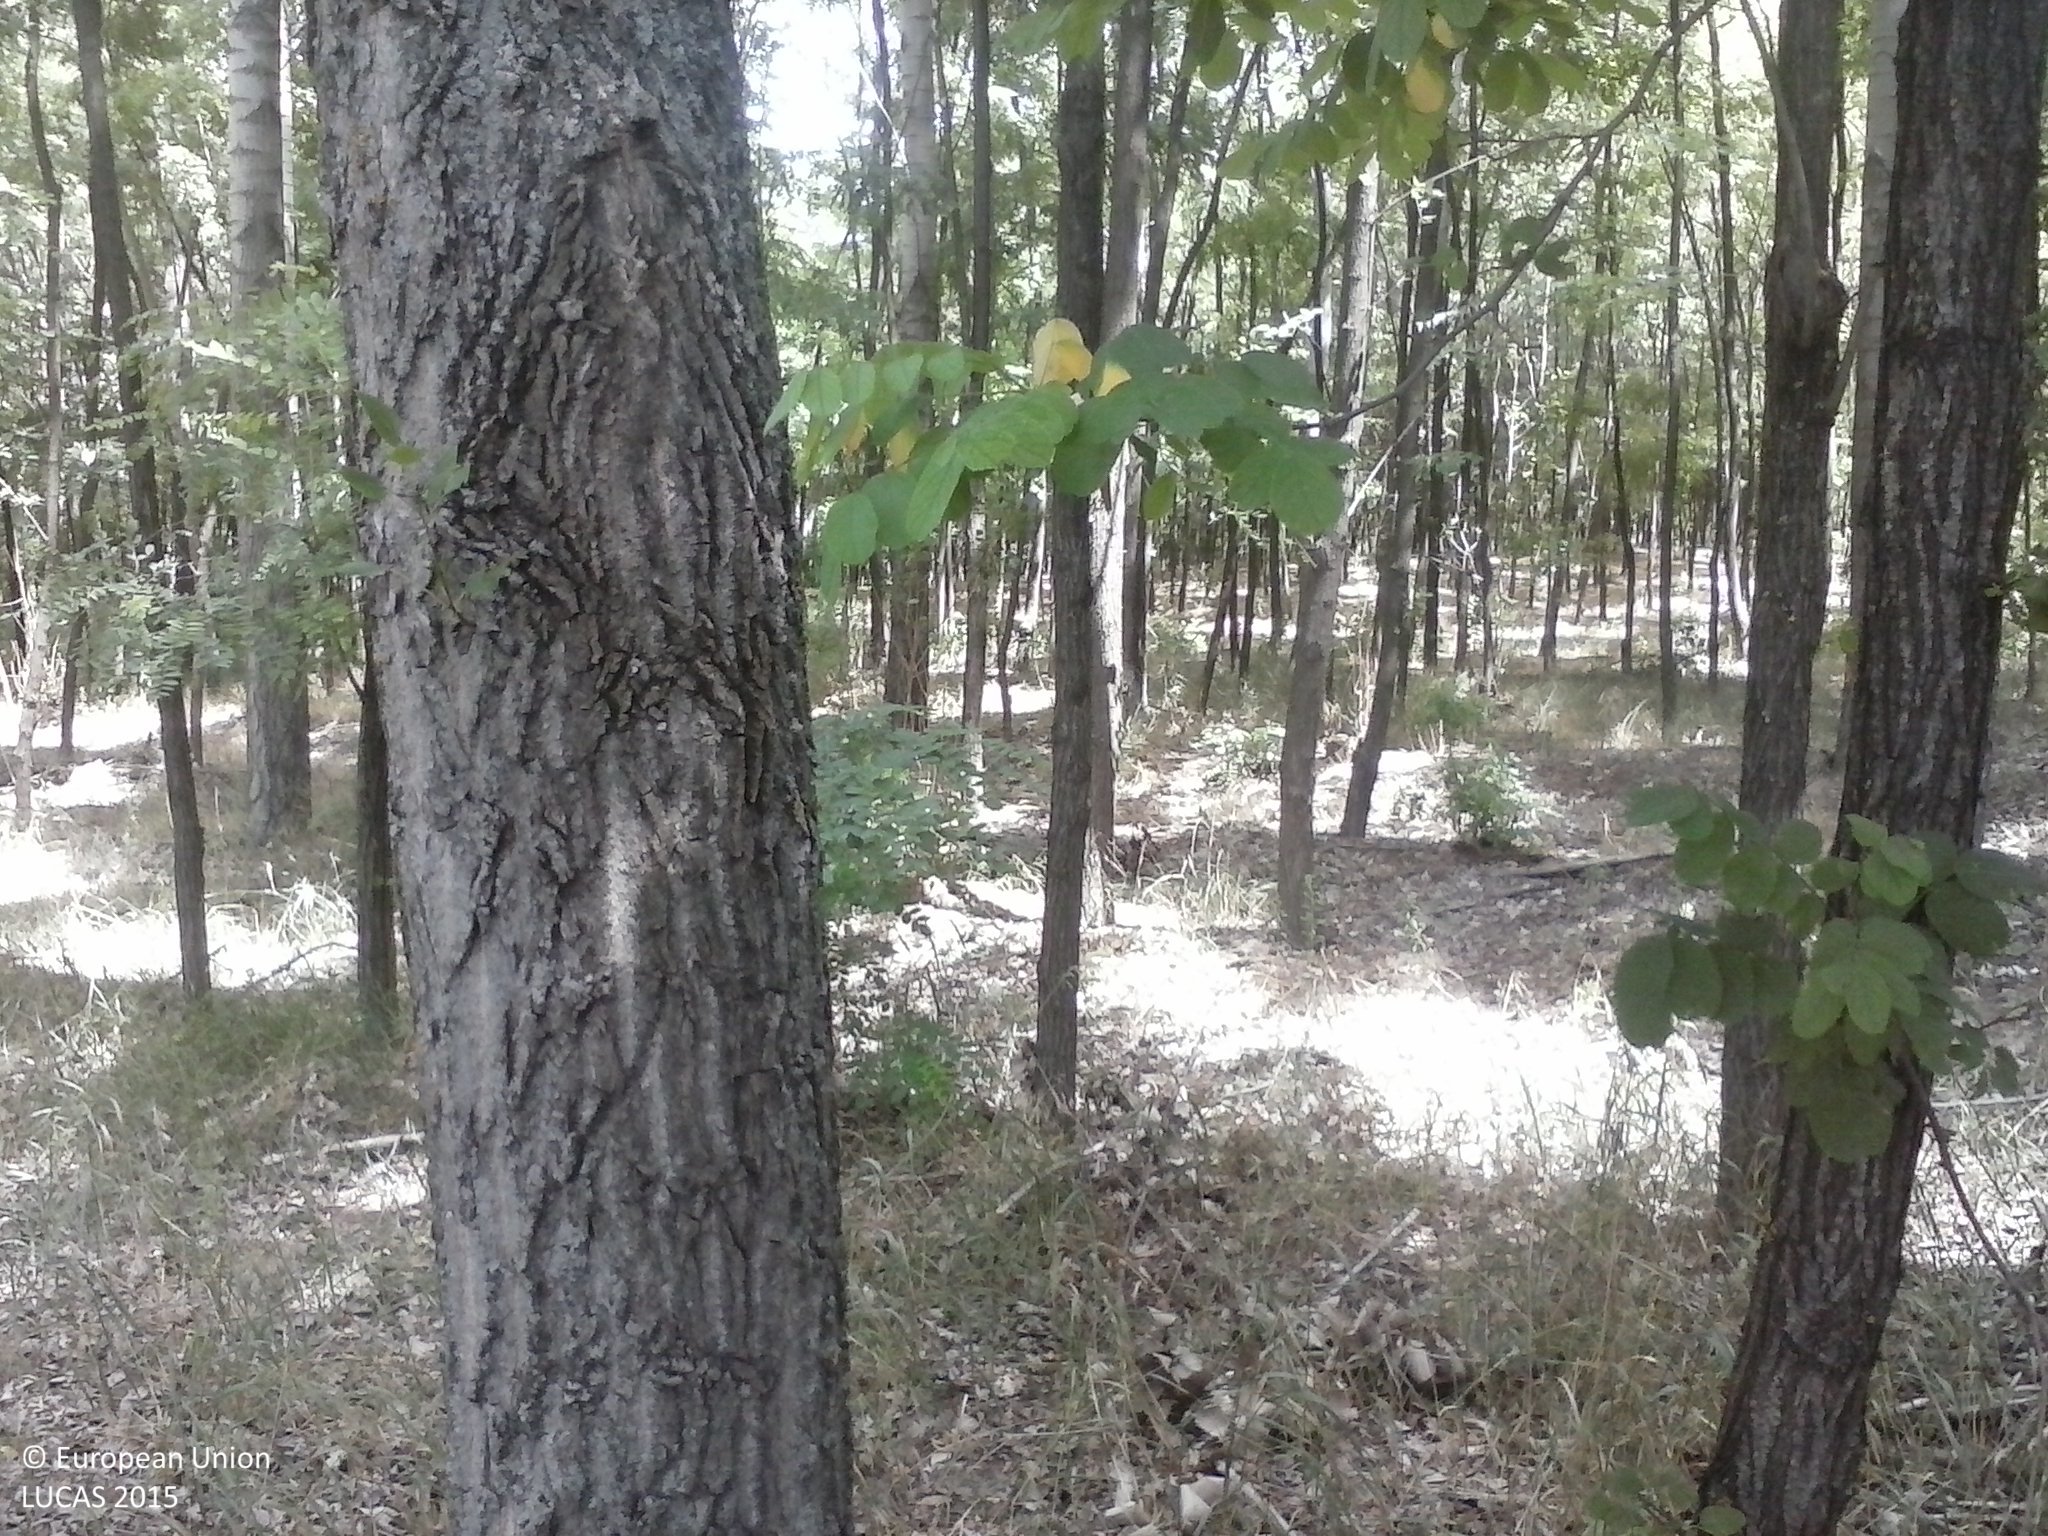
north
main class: Woodland
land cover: Broadleaved woodland
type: mesophytic deciduous forest
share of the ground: > 75 %
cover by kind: broadleaved forest trees 90 %, shrubs 5 %, herbaceous plants 5 %
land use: Forestry
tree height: > 5 m
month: July
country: HU
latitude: 46.6015
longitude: 19.6665
